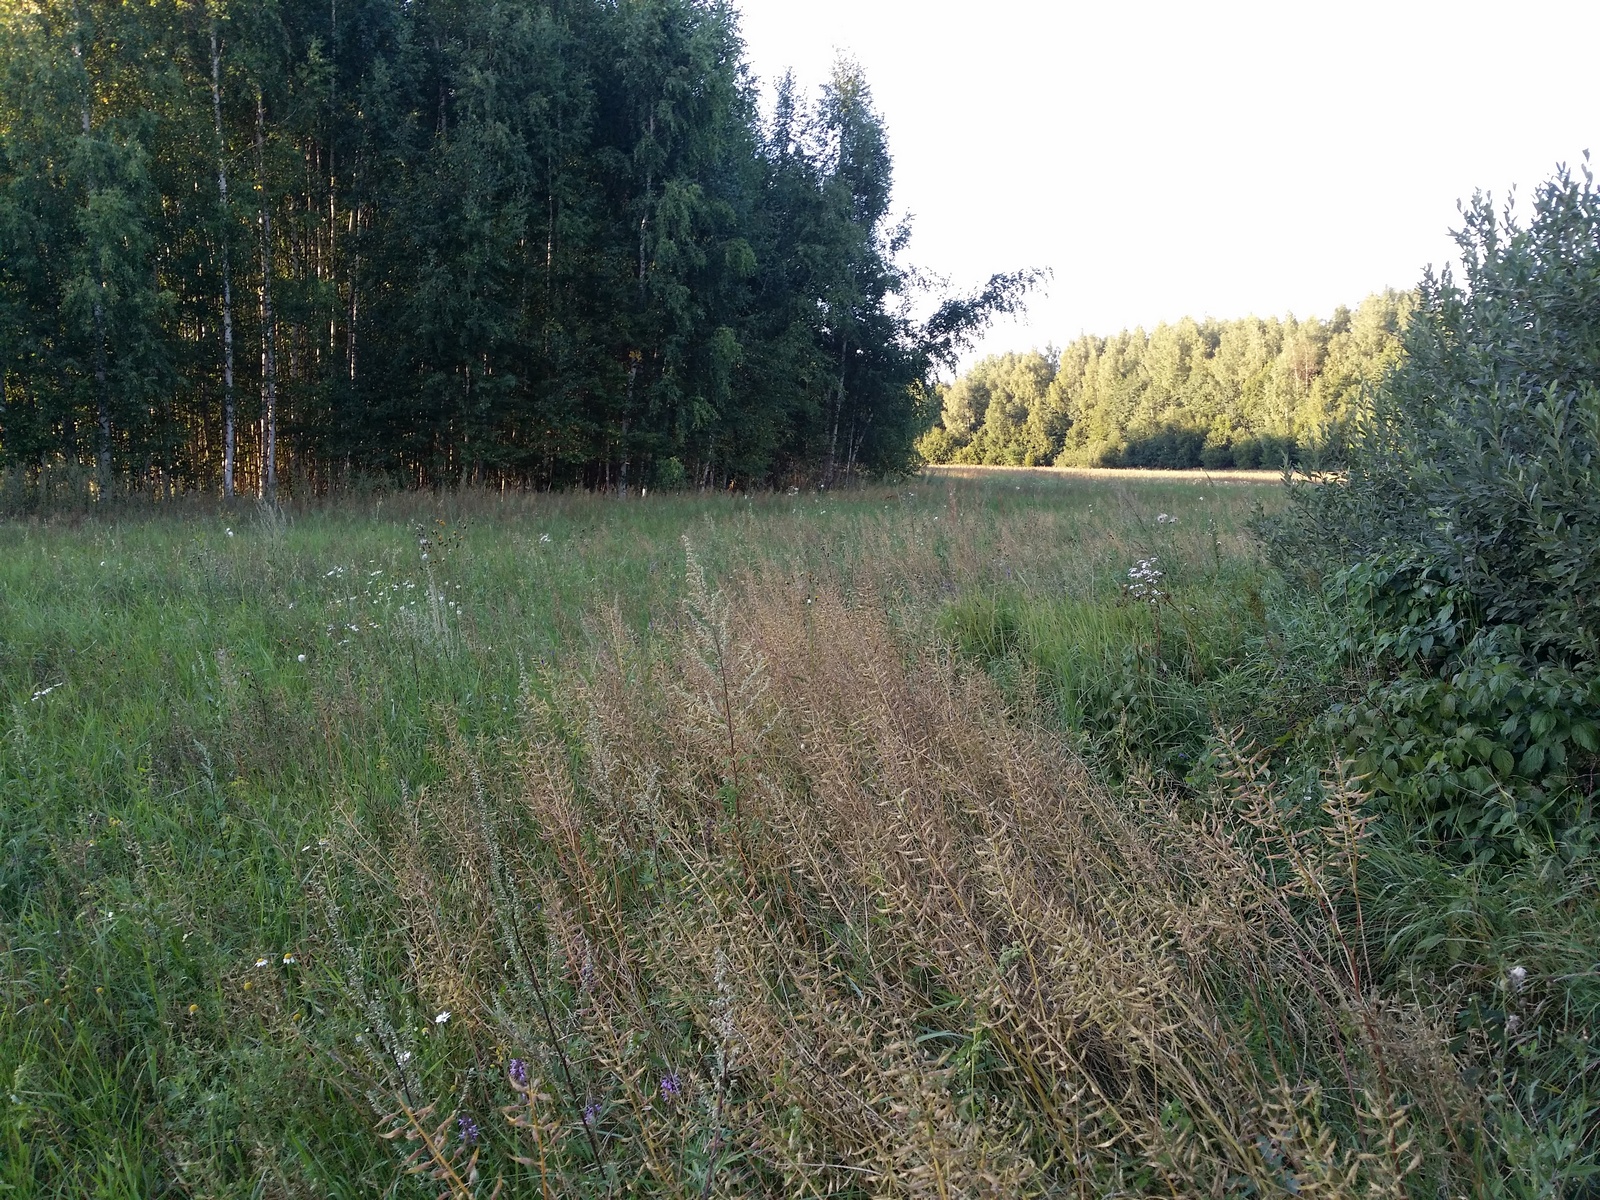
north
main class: Grassland
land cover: Spontaneously vegetated surfaces
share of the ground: > 75 %
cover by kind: herbaceous plants 100 %
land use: Fallow land
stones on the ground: < 10 %
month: August
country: LV
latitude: 56.9432
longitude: 27.5194
